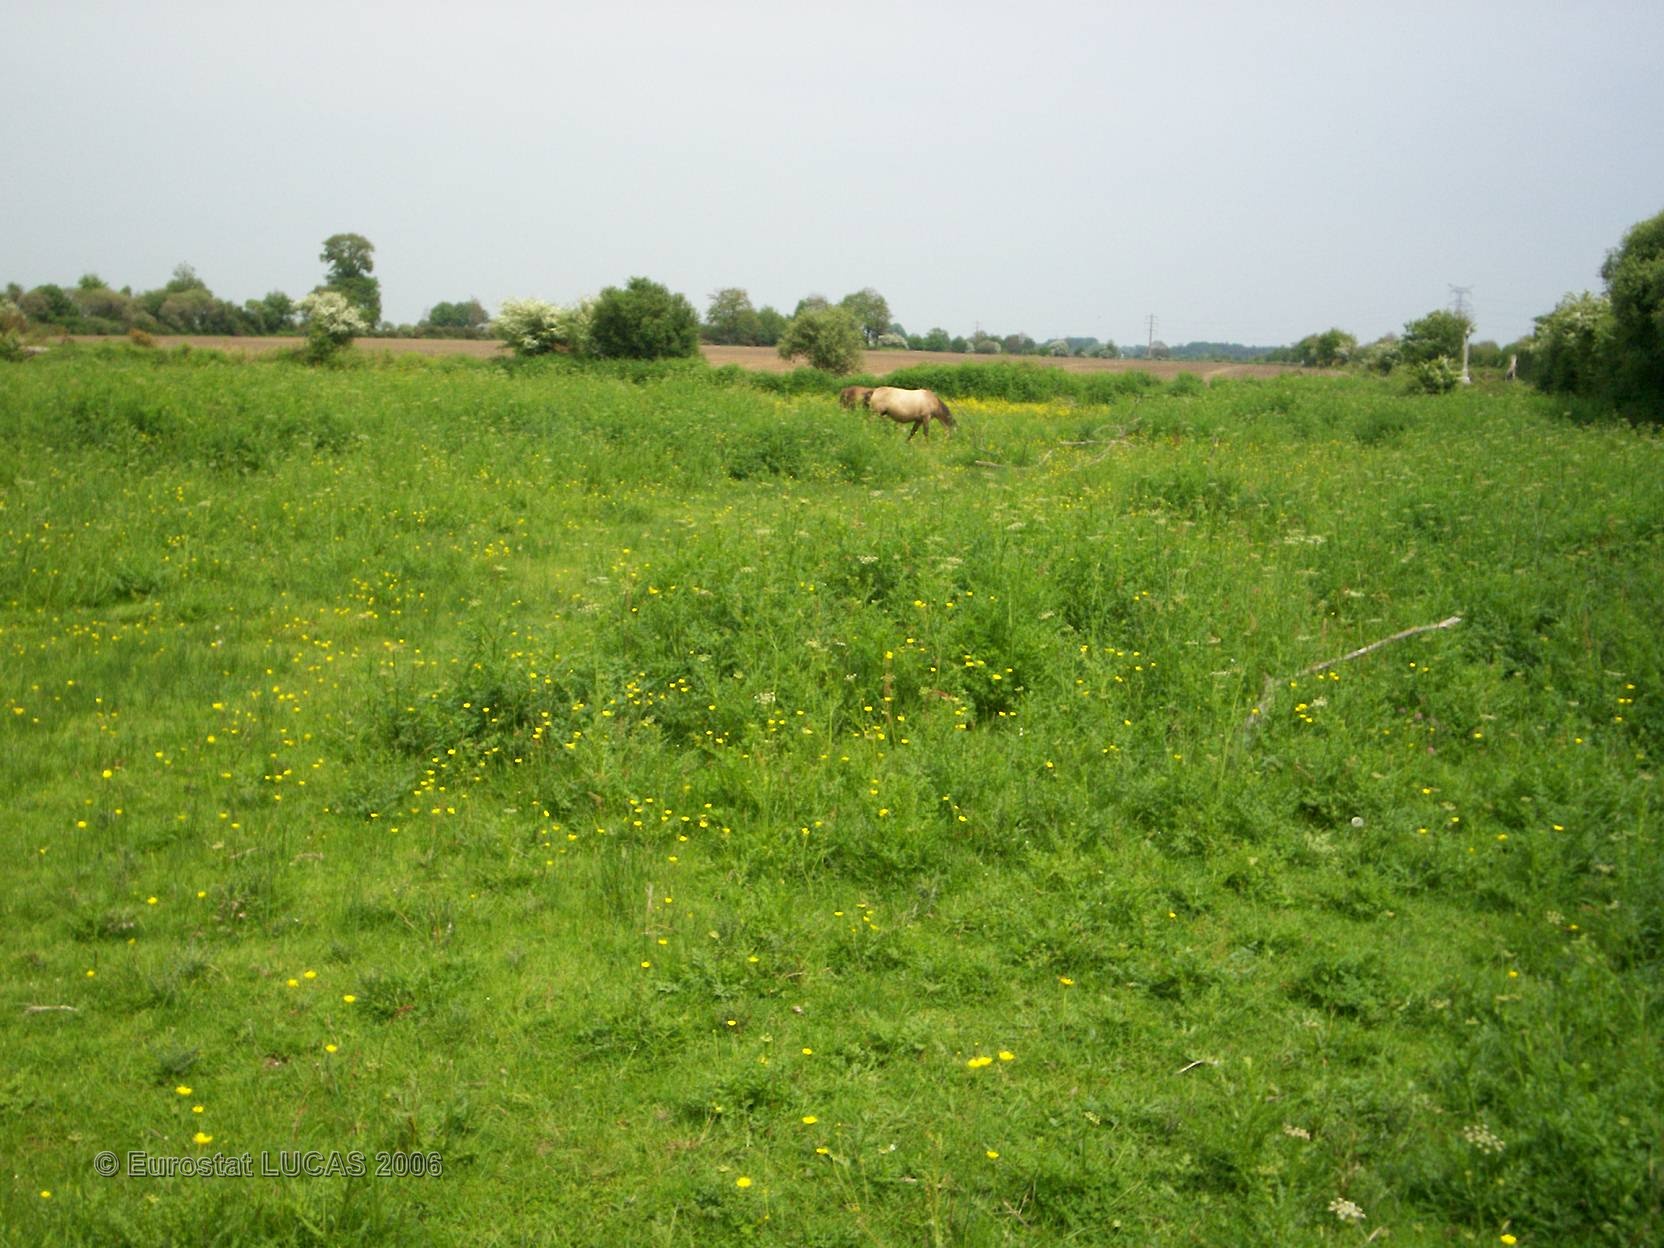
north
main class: Grassland
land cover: Grassland without tree/shrub cover
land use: Agriculture (excluding fallow land and kitchen gardens)
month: May
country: FR
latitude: 47.5841
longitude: -1.4913
